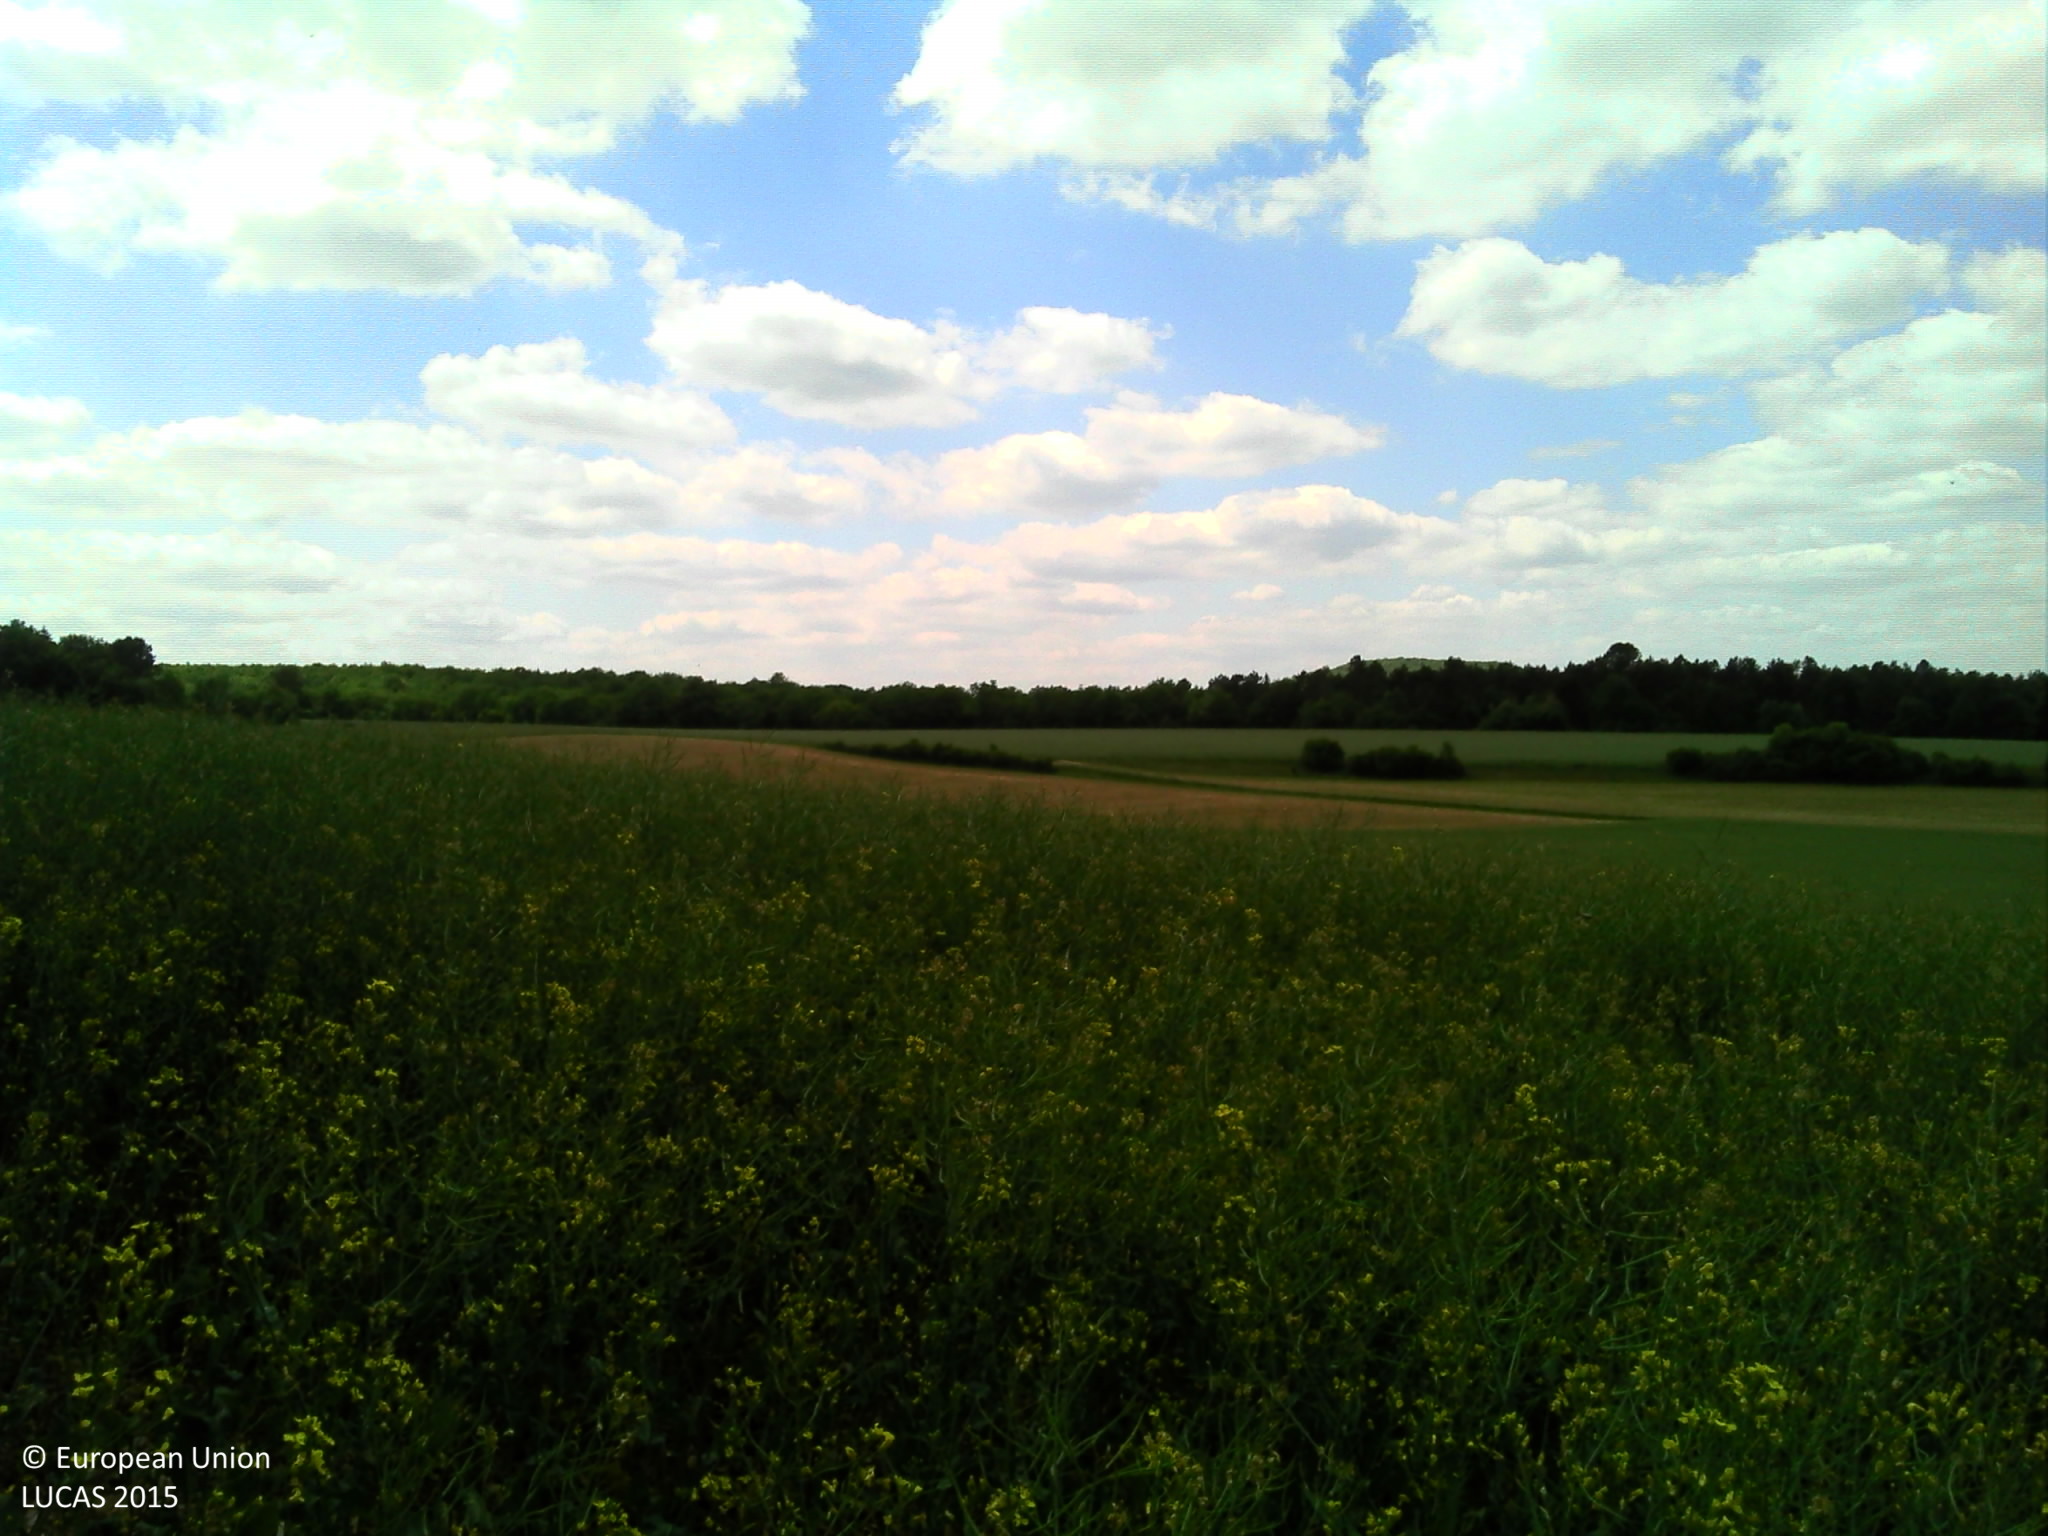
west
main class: Cropland
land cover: Rape and turnip rape
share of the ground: > 75 %
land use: Agriculture (excluding fallow land and kitchen gardens)
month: May
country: FR
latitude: 47.4981
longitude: 5.0221
